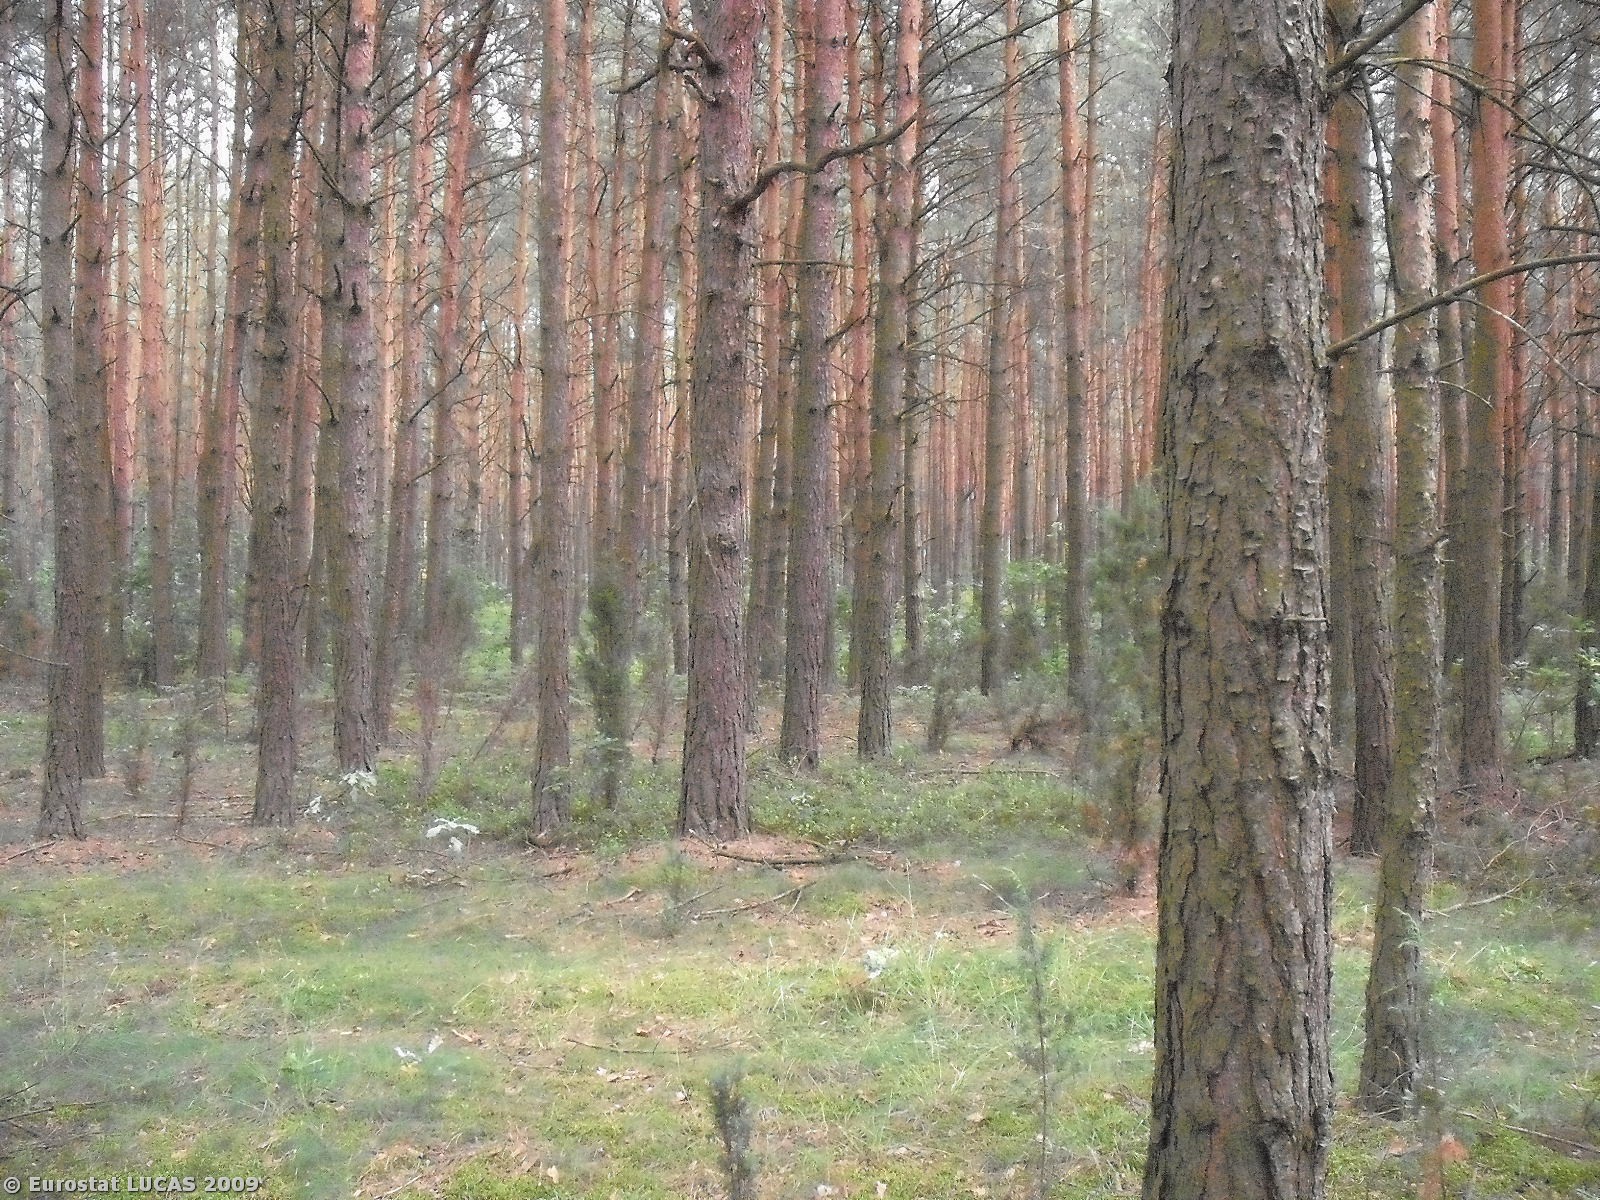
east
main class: Woodland
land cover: Coniferous woodland
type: hemiboreal forest and nemoral coniferous forest and mixed broadleaved-coniferous forest
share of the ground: > 75 %
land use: Forestry
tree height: > 5 m
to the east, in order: Coniferous woodland; Tracks; Coniferous woodland; Tracks; Coniferous woodland
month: July
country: PL
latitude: 51.2646
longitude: 21.3859
